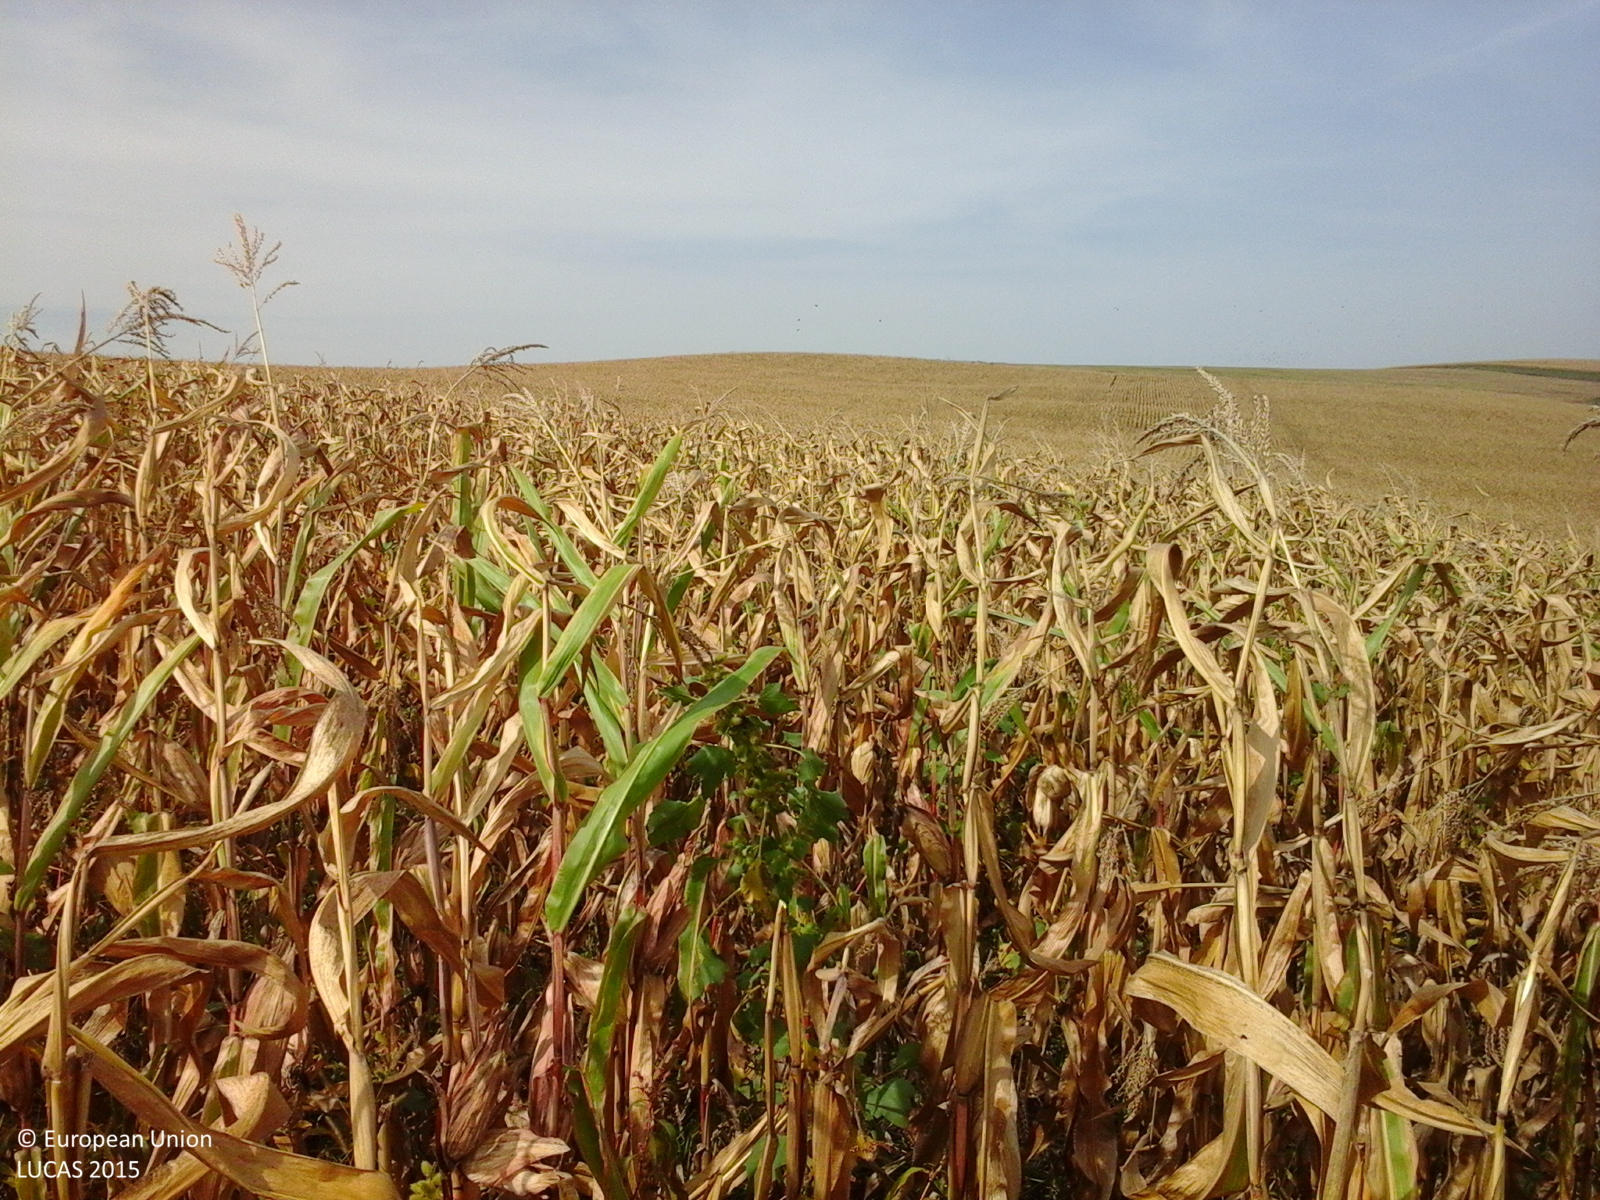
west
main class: Cropland
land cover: Maize
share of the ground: > 75 %
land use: Agriculture (excluding fallow land and kitchen gardens)
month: September
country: RO
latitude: 46.8135
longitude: 23.7166
